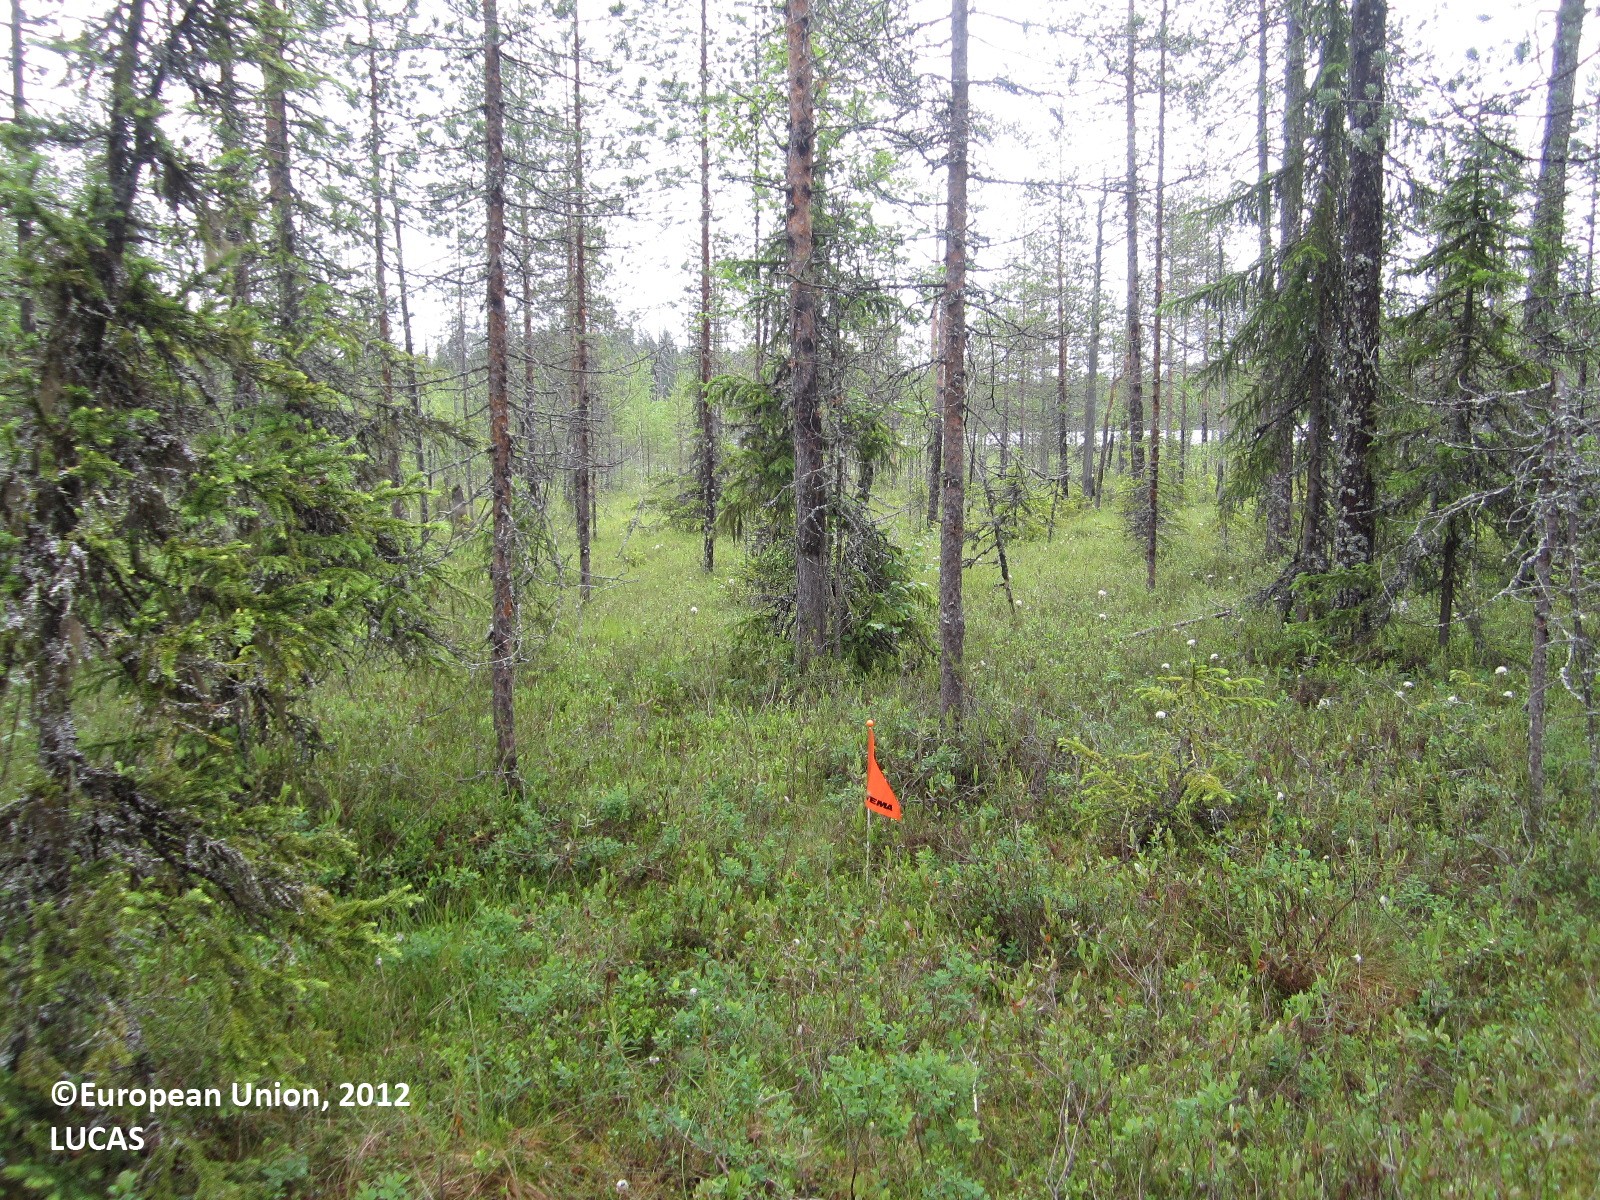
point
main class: Woodland
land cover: Spruce dominated coniferous woodland
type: mire and swamp forests
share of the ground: 50 - 75 %
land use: Forestry
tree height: > 5 m
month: June
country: FI
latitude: 64.5441
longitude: 29.5879
